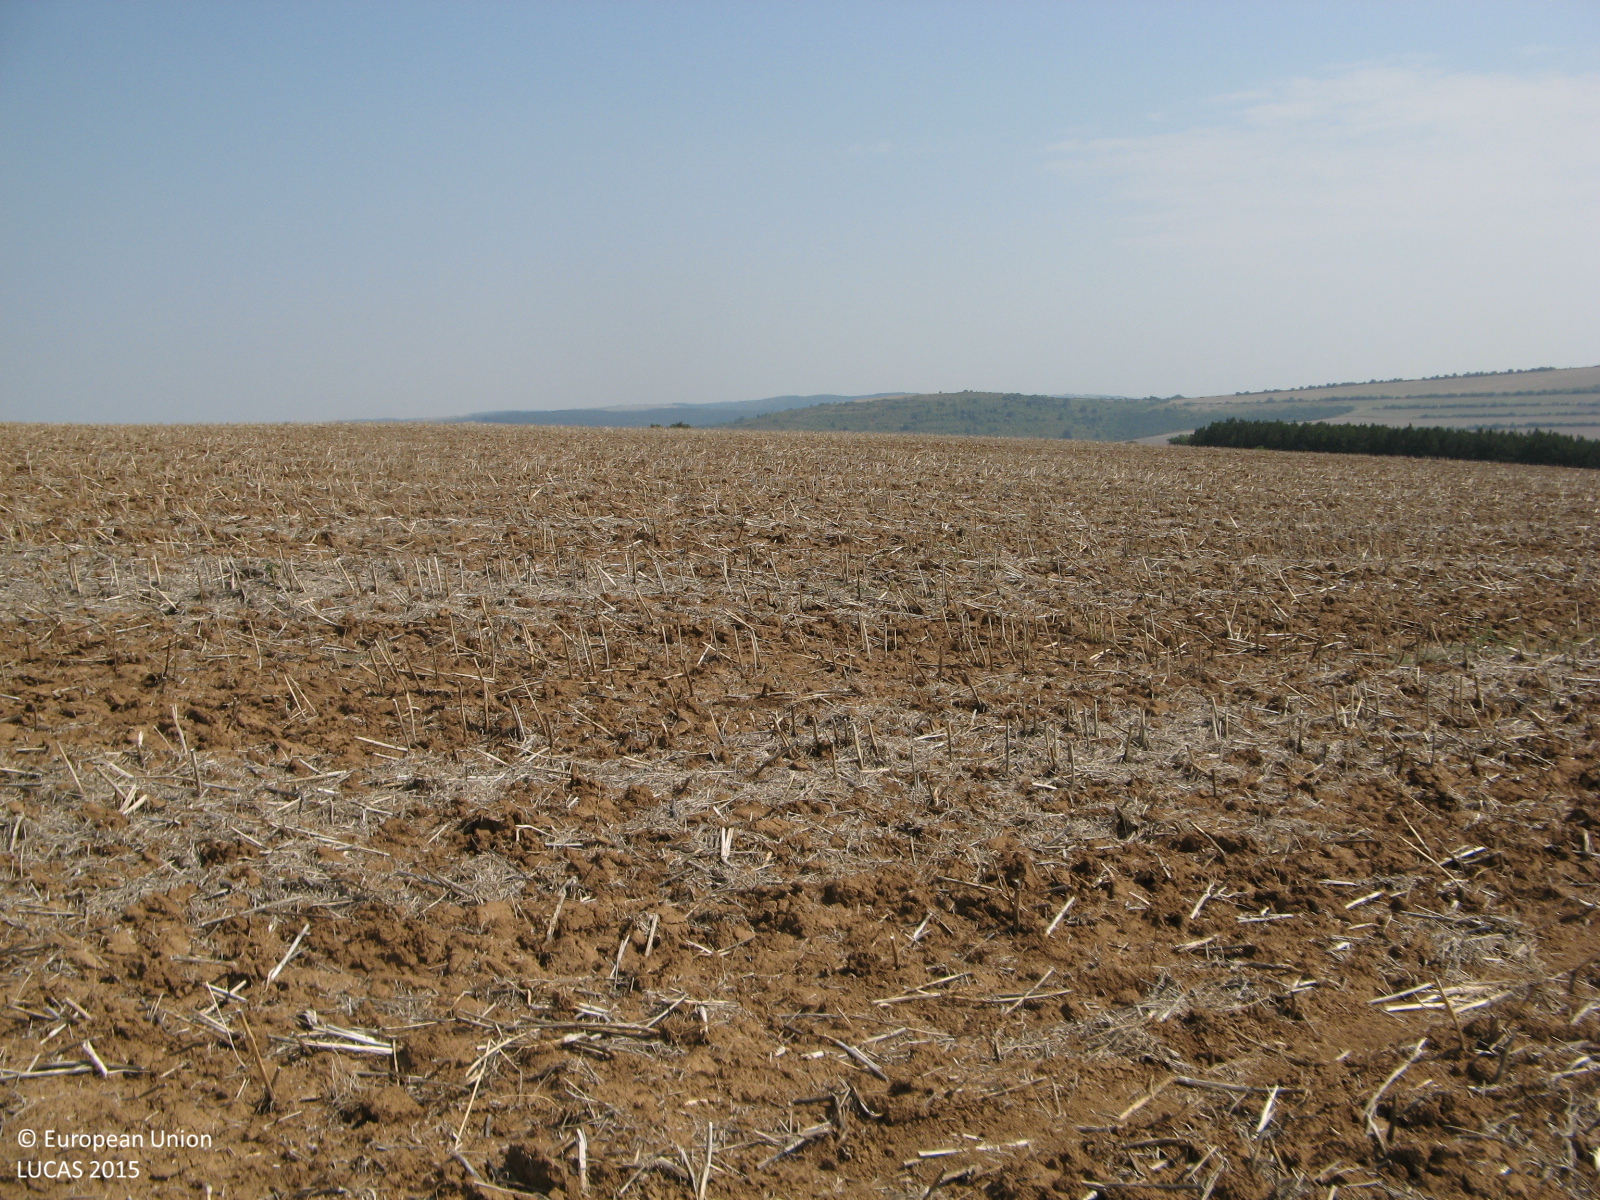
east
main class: Cropland
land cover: Rape and turnip rape
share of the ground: < 10 %
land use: Agriculture (excluding fallow land and kitchen gardens)
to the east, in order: Rape and turnip rape
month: August
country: BG
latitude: 43.3976
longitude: 25.8549
